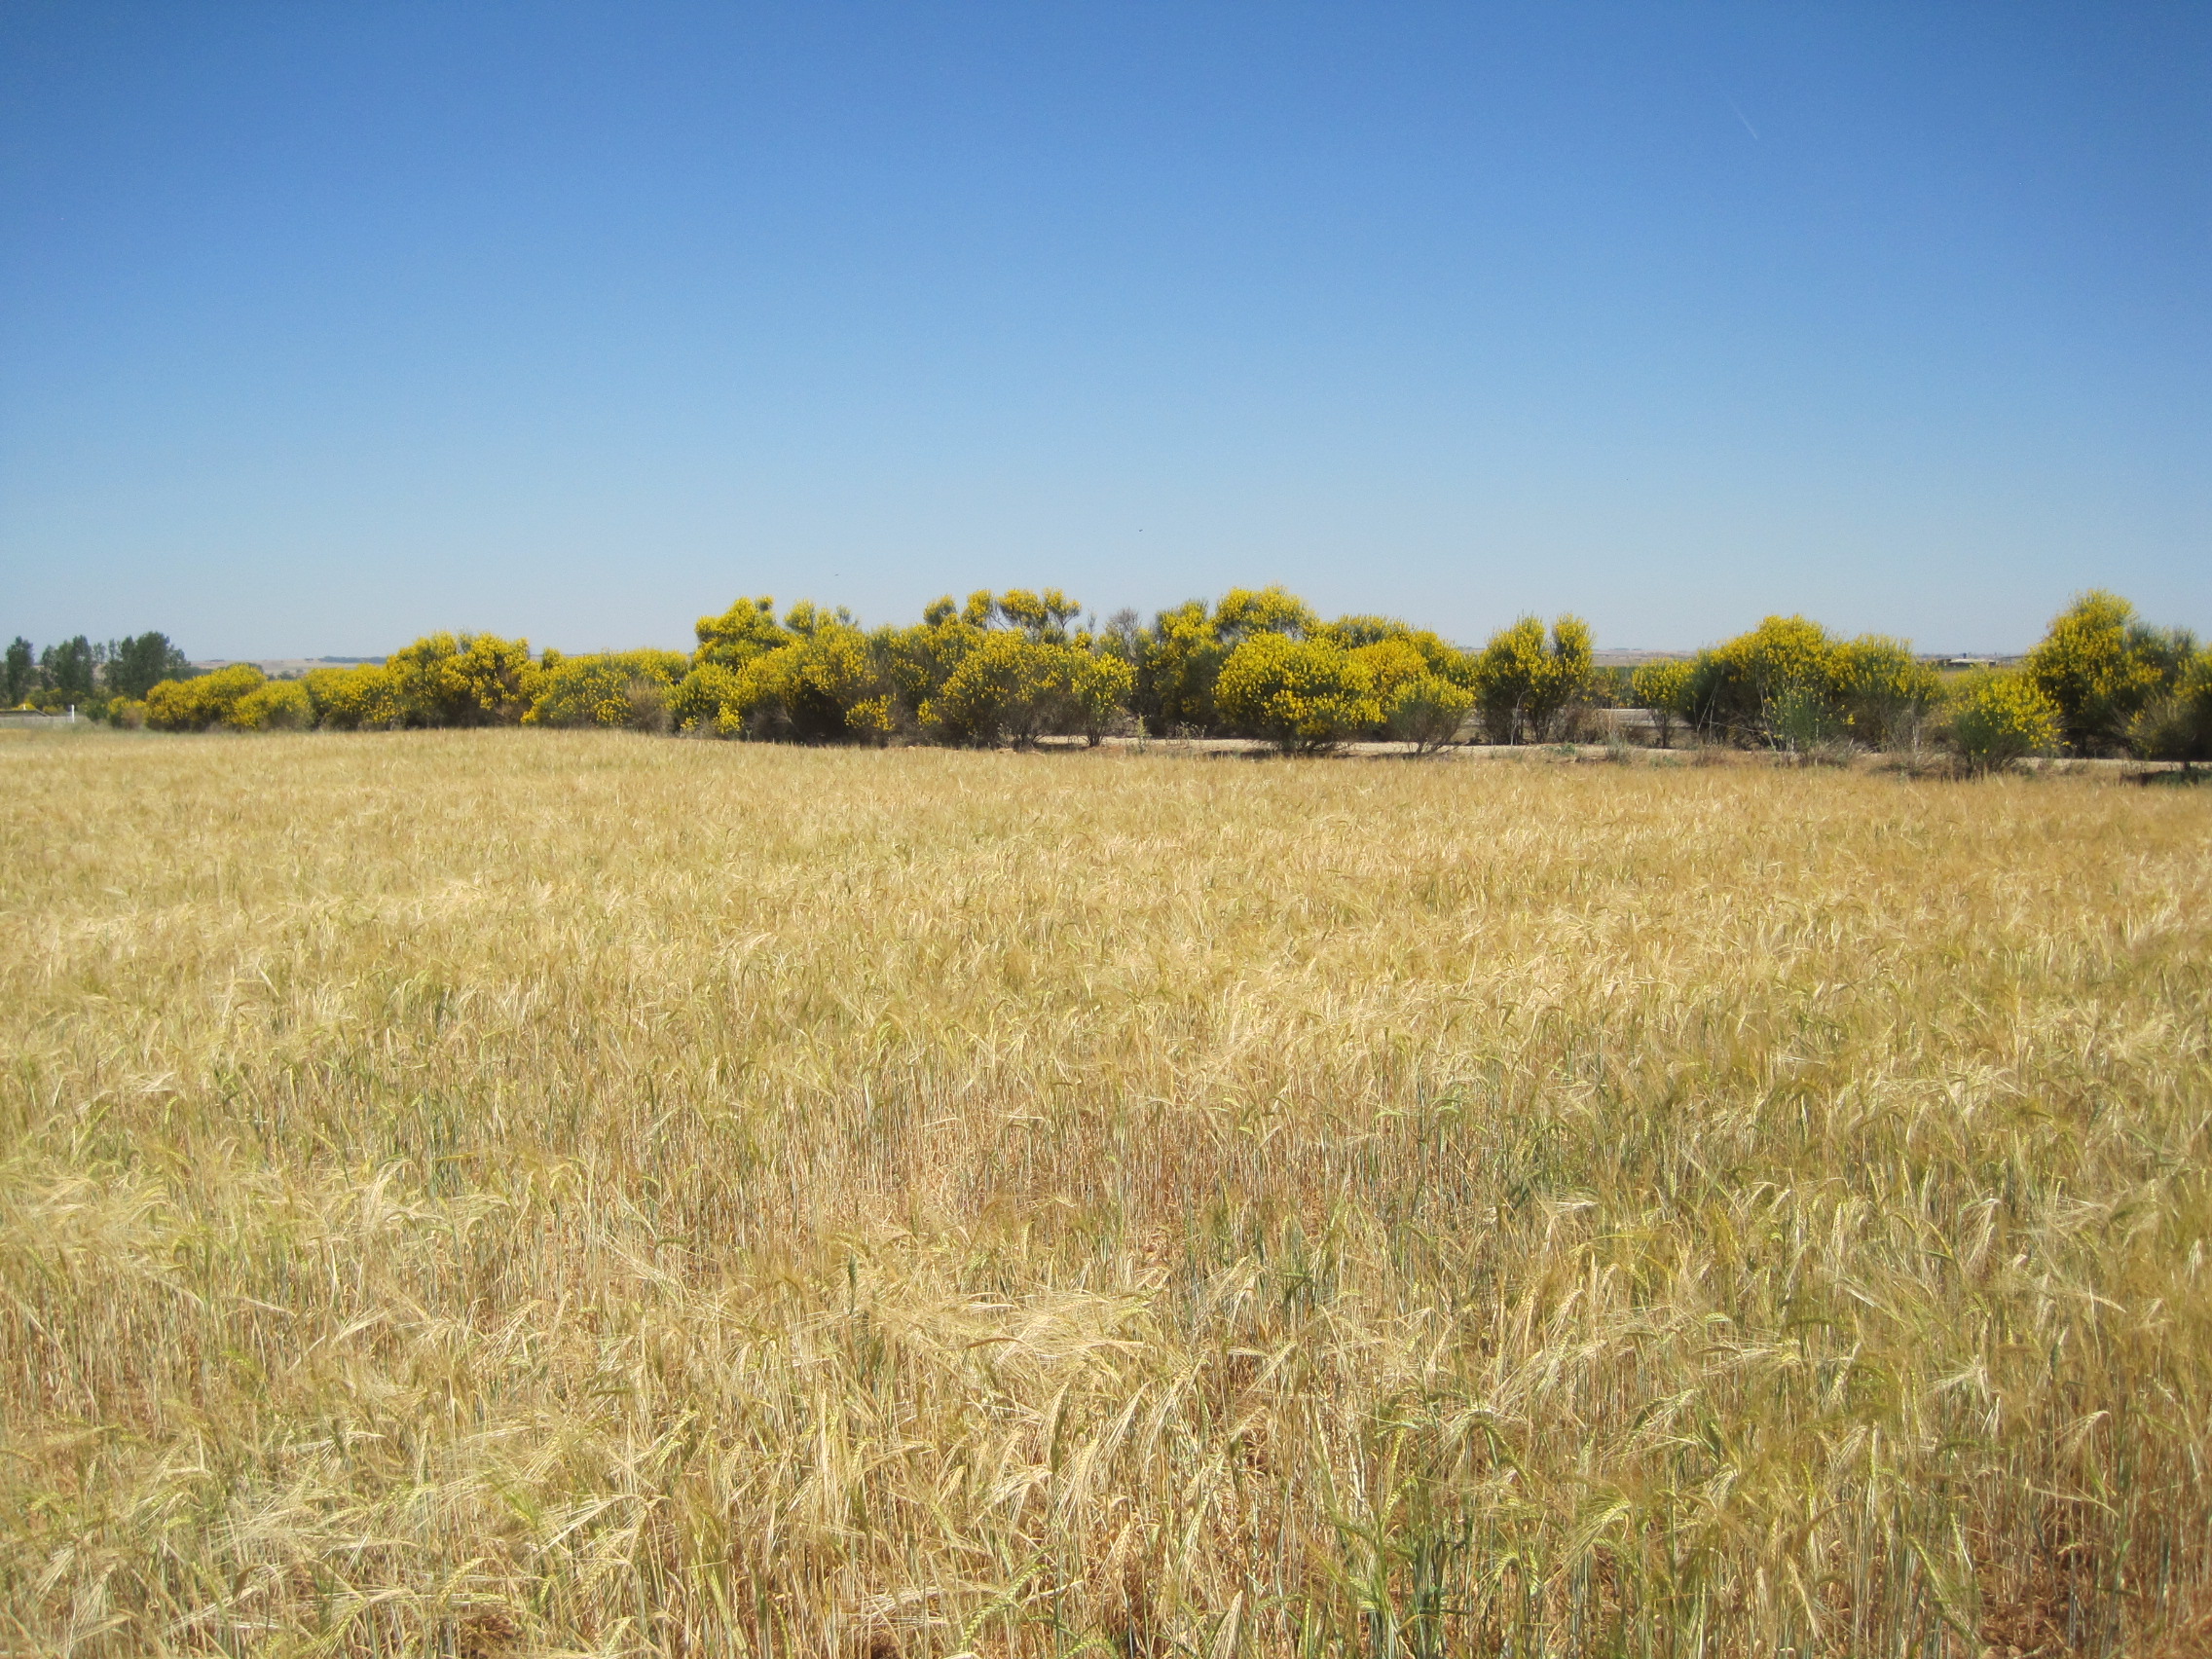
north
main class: Cropland
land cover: Barley
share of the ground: > 75 %
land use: Agriculture (excluding fallow land and kitchen gardens)
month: June
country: ES
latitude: 41.8368
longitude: -5.3893
